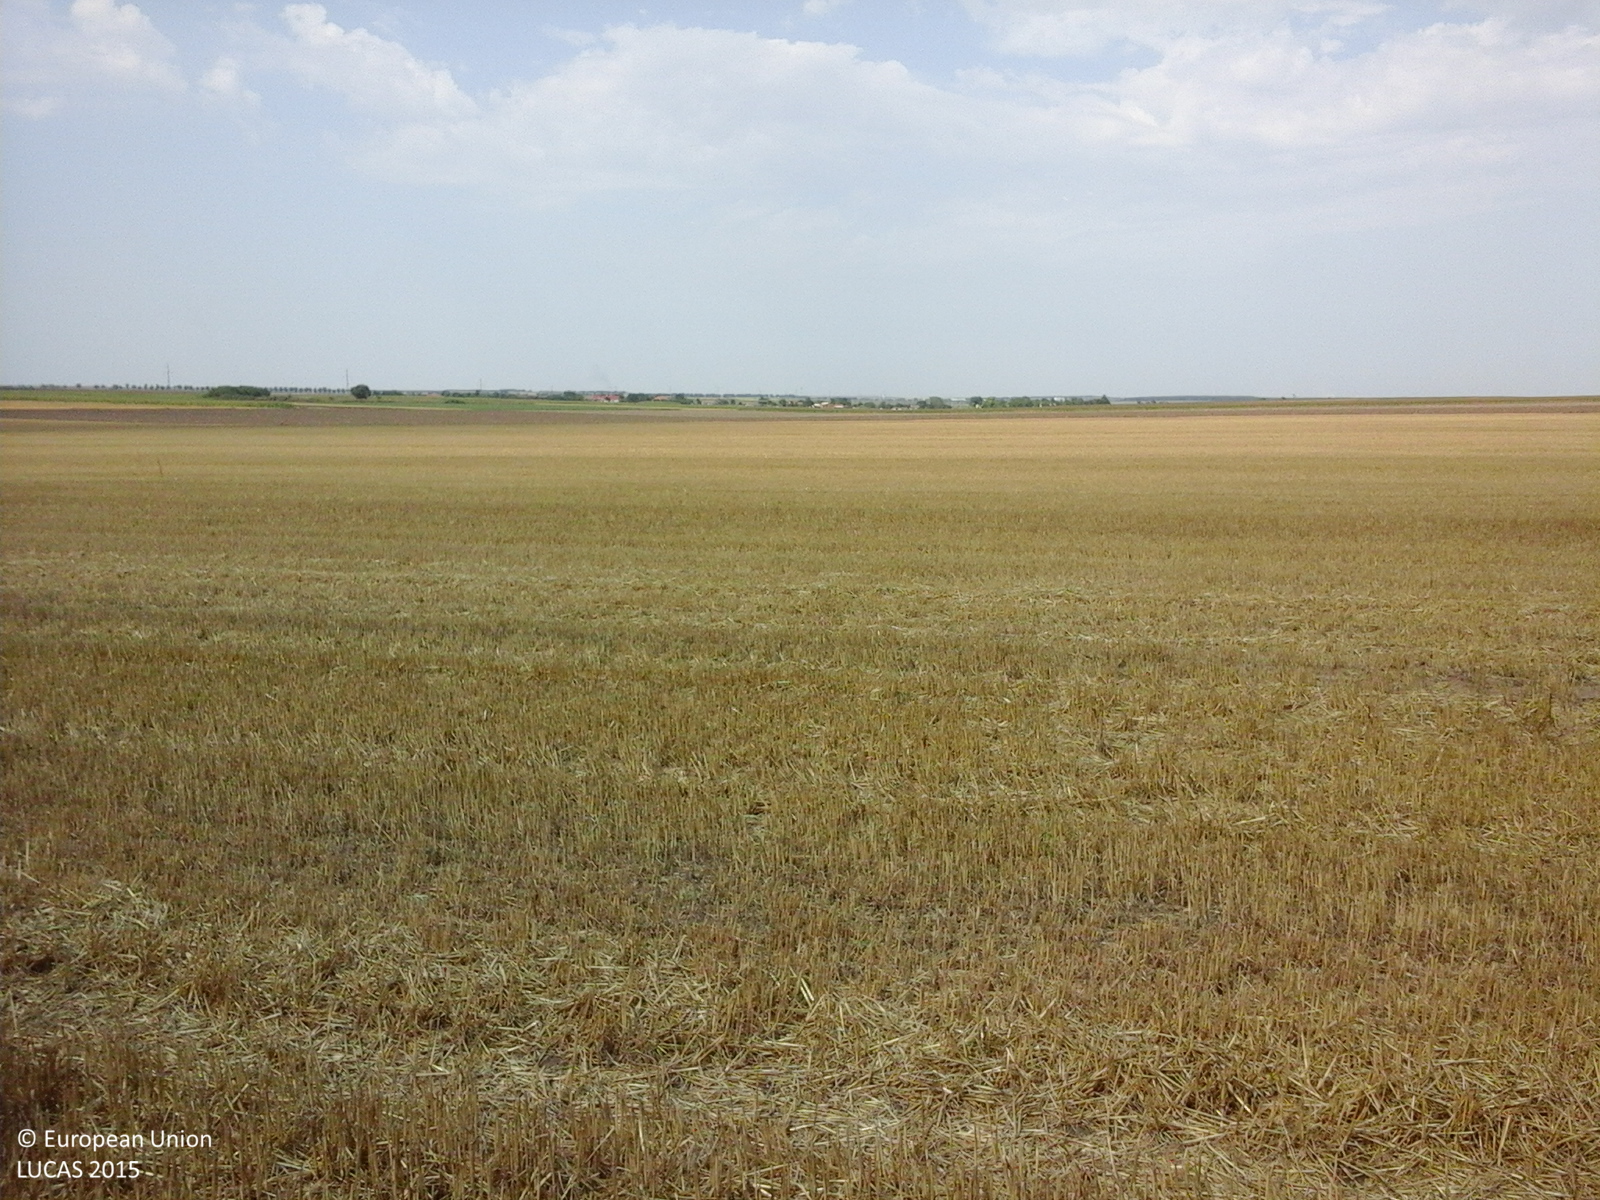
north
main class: Cropland
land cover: Sunflower
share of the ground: > 75 %
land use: Agriculture (excluding fallow land and kitchen gardens)
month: August
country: RO
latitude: 43.9098
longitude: 28.3799
